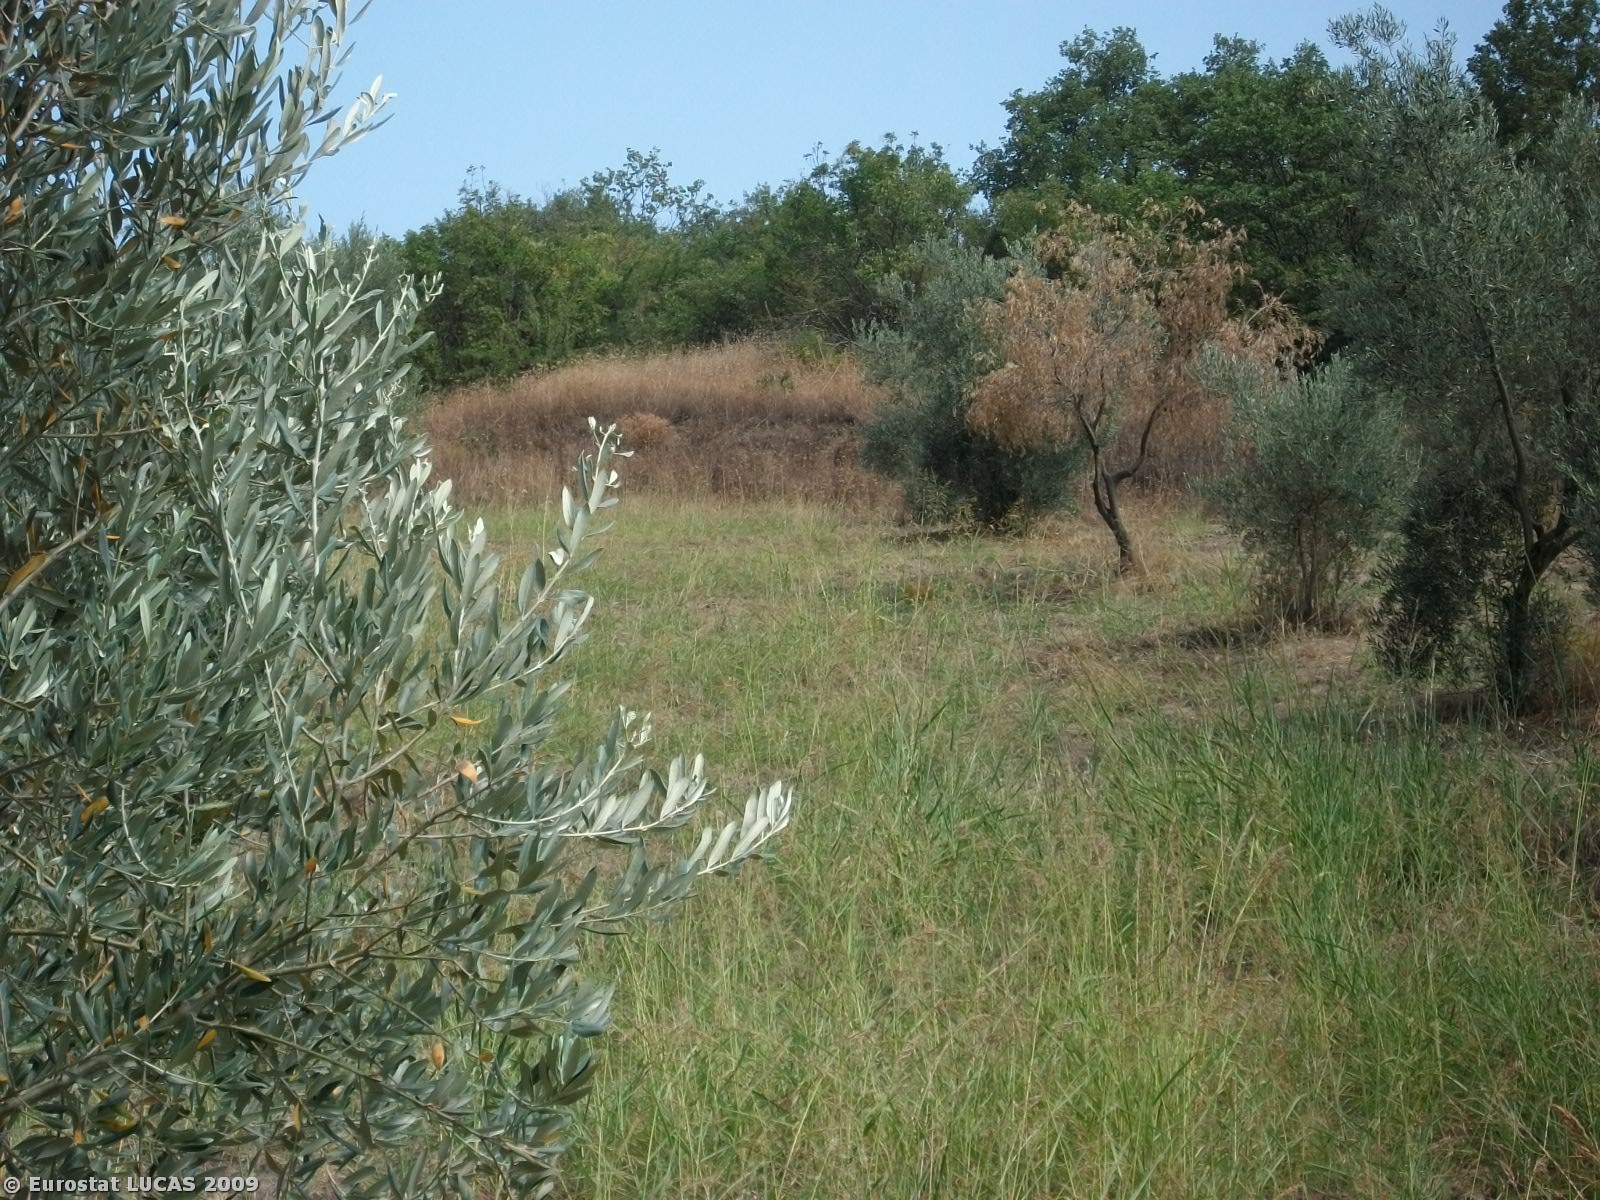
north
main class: Cropland
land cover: Olive groves
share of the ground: 25 - 50 %
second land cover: Grassland with sparse tree/shrub cover
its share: > 75 %
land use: Agriculture (excluding fallow land and kitchen gardens)
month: August
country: GR
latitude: 38.7645
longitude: 22.6751
